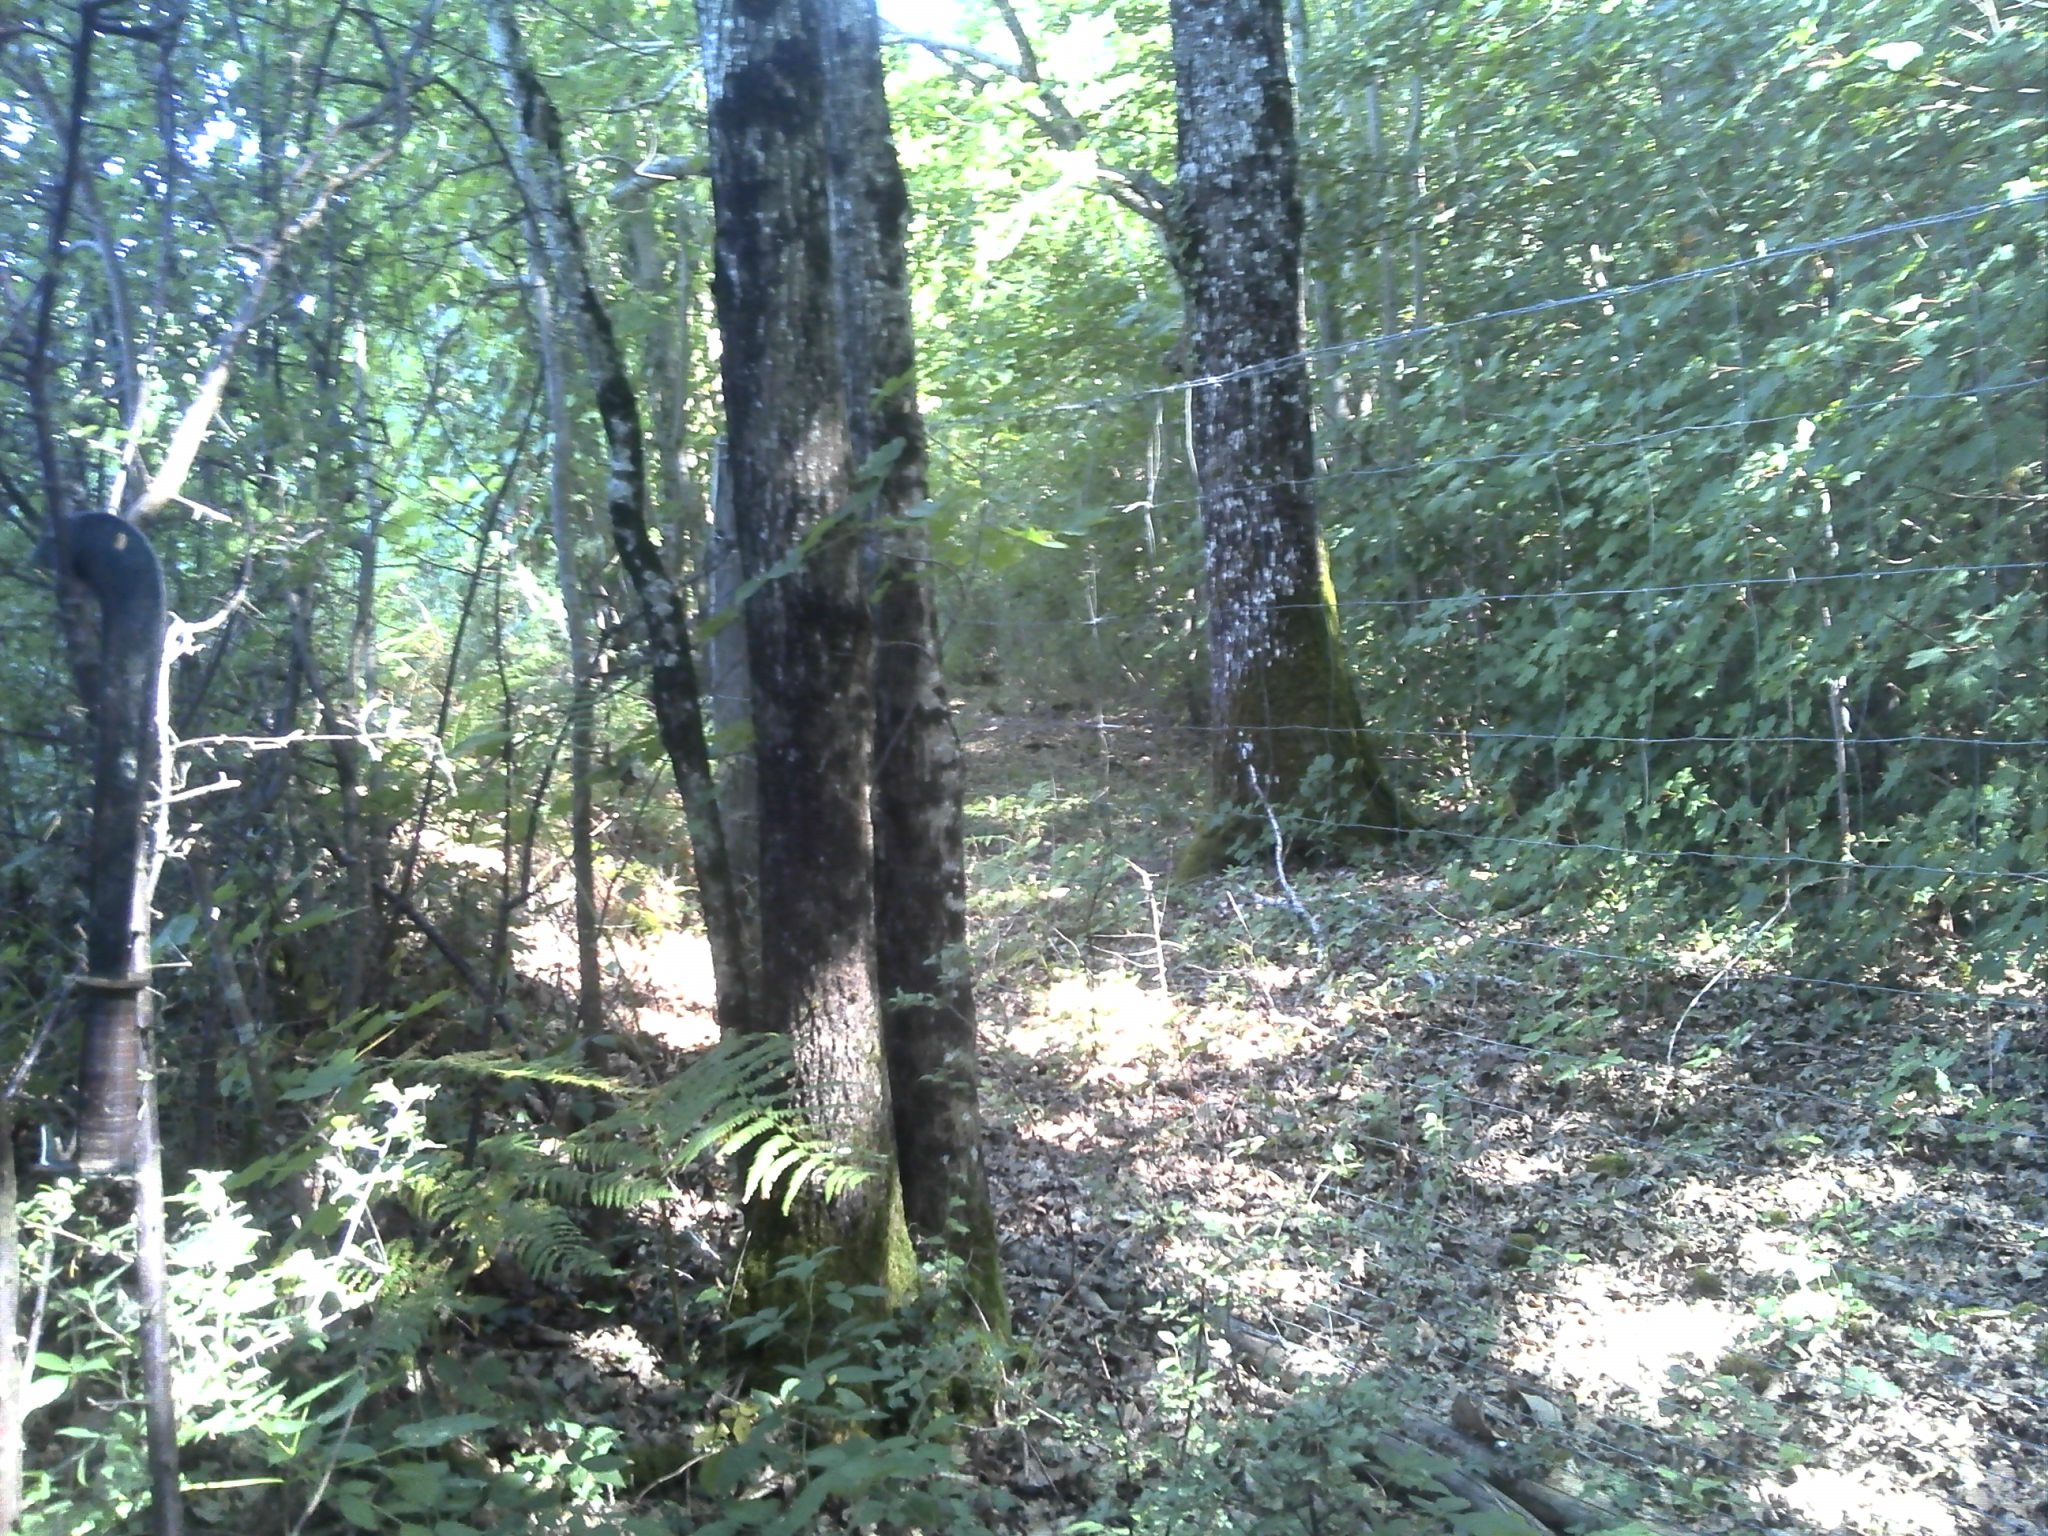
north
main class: Woodland
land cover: Broadleaved woodland
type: mesophytic deciduous forest
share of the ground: > 75 %
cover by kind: broadleaved forest trees 90 %, shrubs 5 %, herbaceous plants 5 %
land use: Forestry
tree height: > 5 m
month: July
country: FR
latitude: 47.0166
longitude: 1.6086
